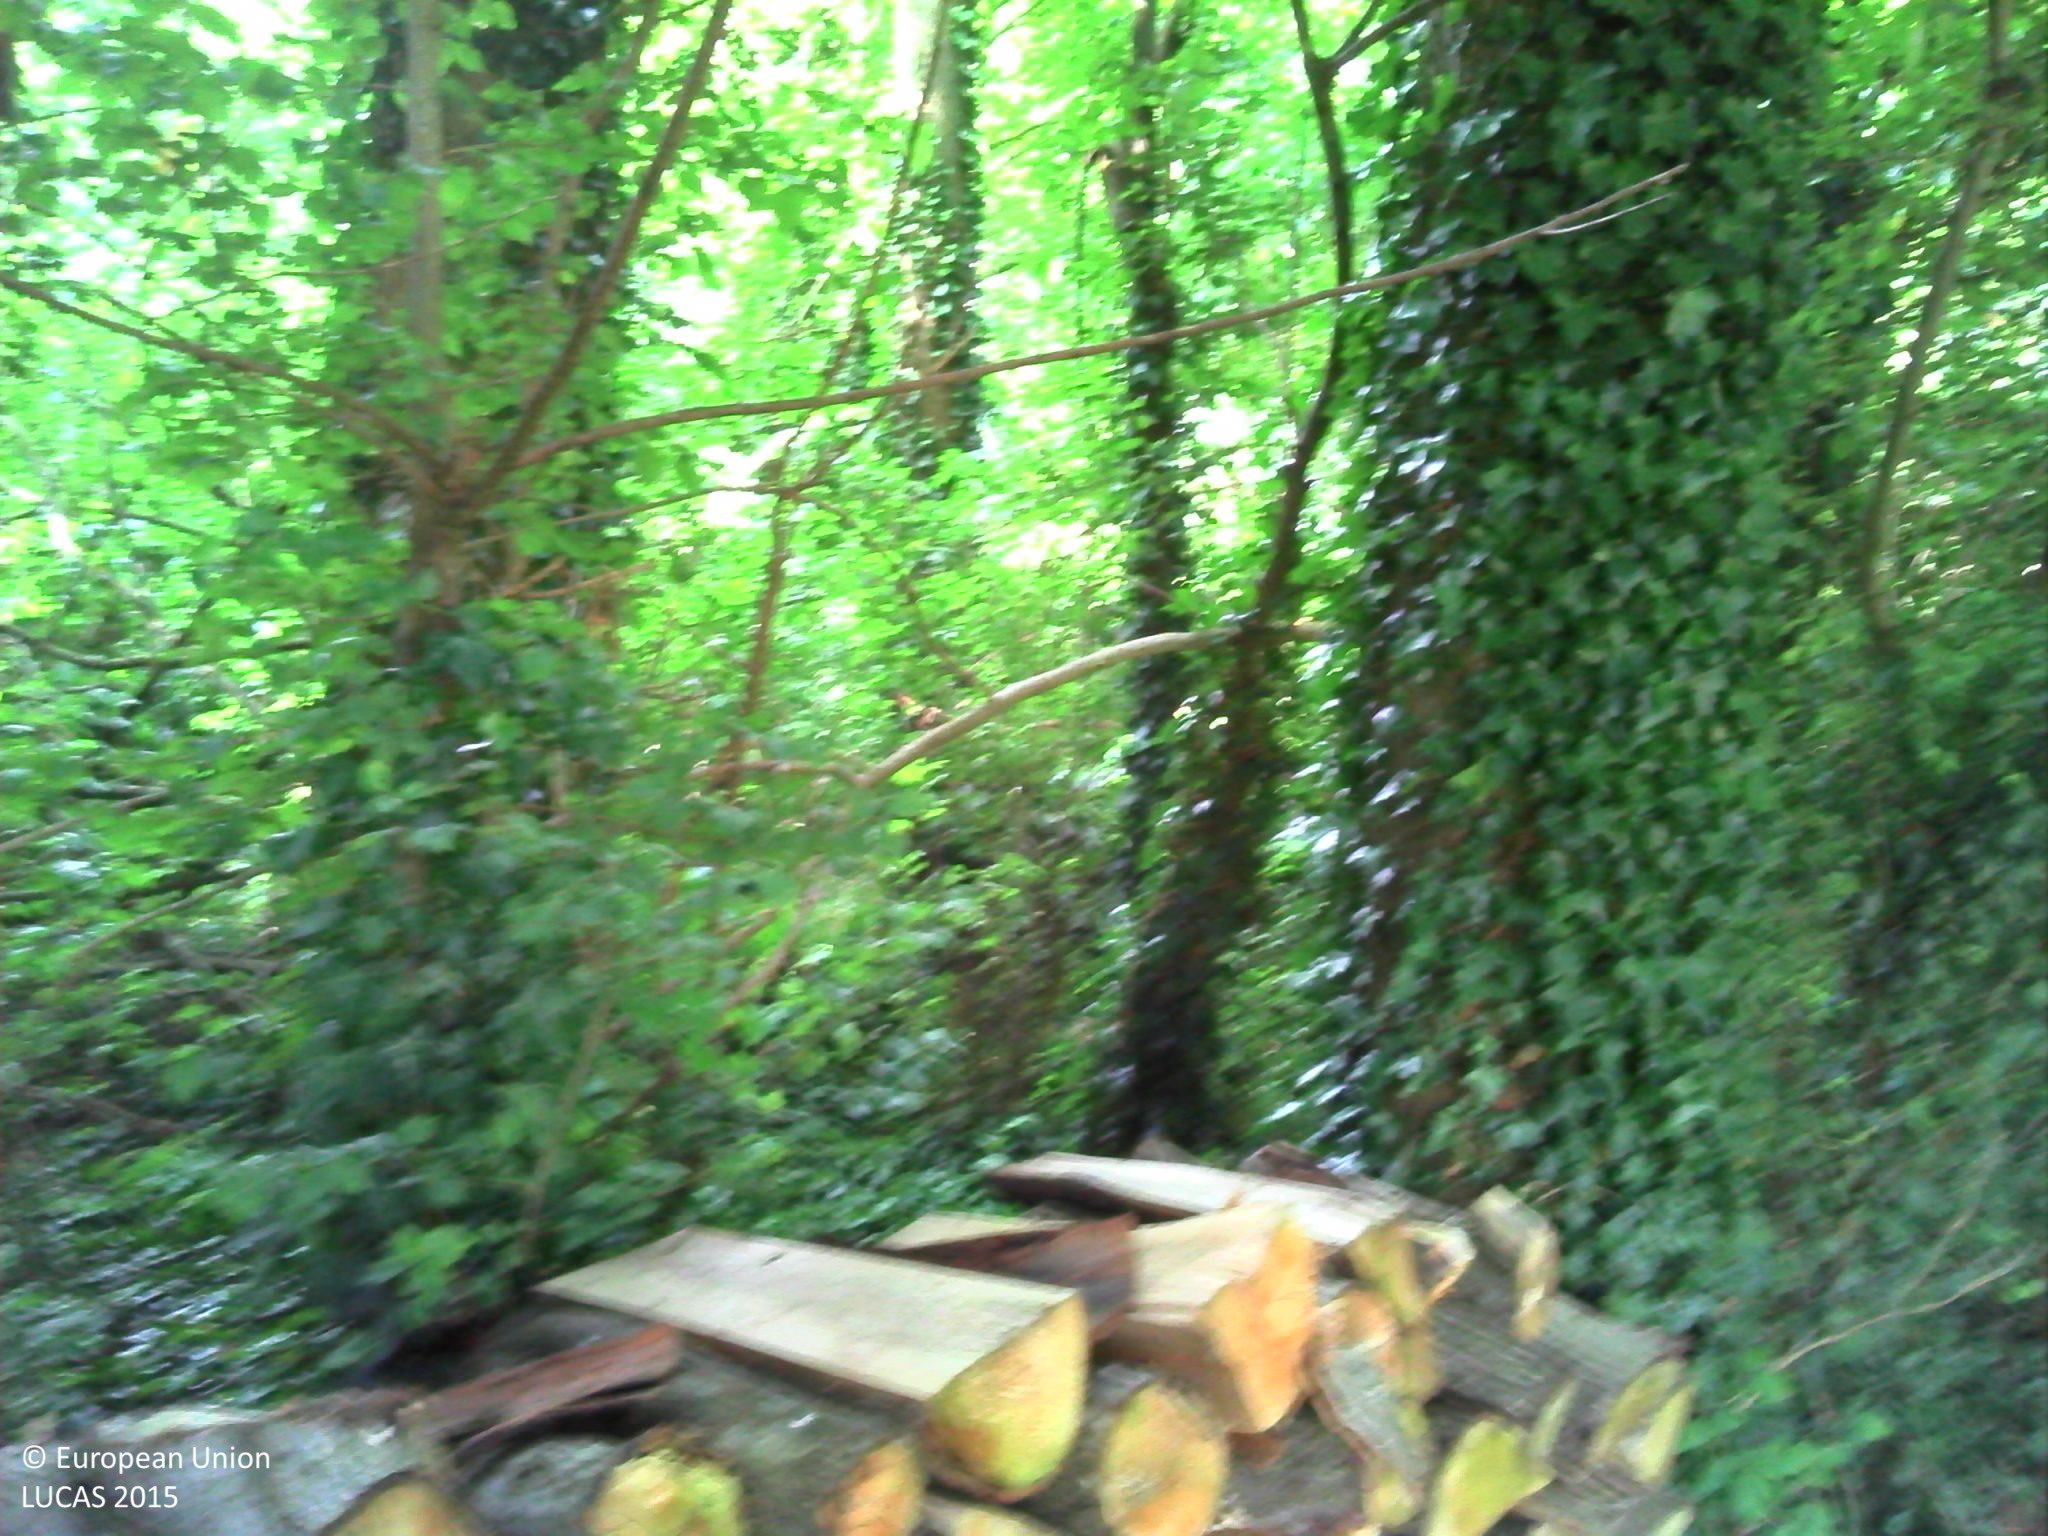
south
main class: Woodland
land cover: Broadleaved woodland
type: mesophytic deciduous forest
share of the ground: > 75 %
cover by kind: broadleaved forest trees 90 %, shrubs 5 %, herbaceous plants 5 %
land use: Forestry
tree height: > 5 m
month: July
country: FR
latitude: 49.0829
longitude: -0.2889
